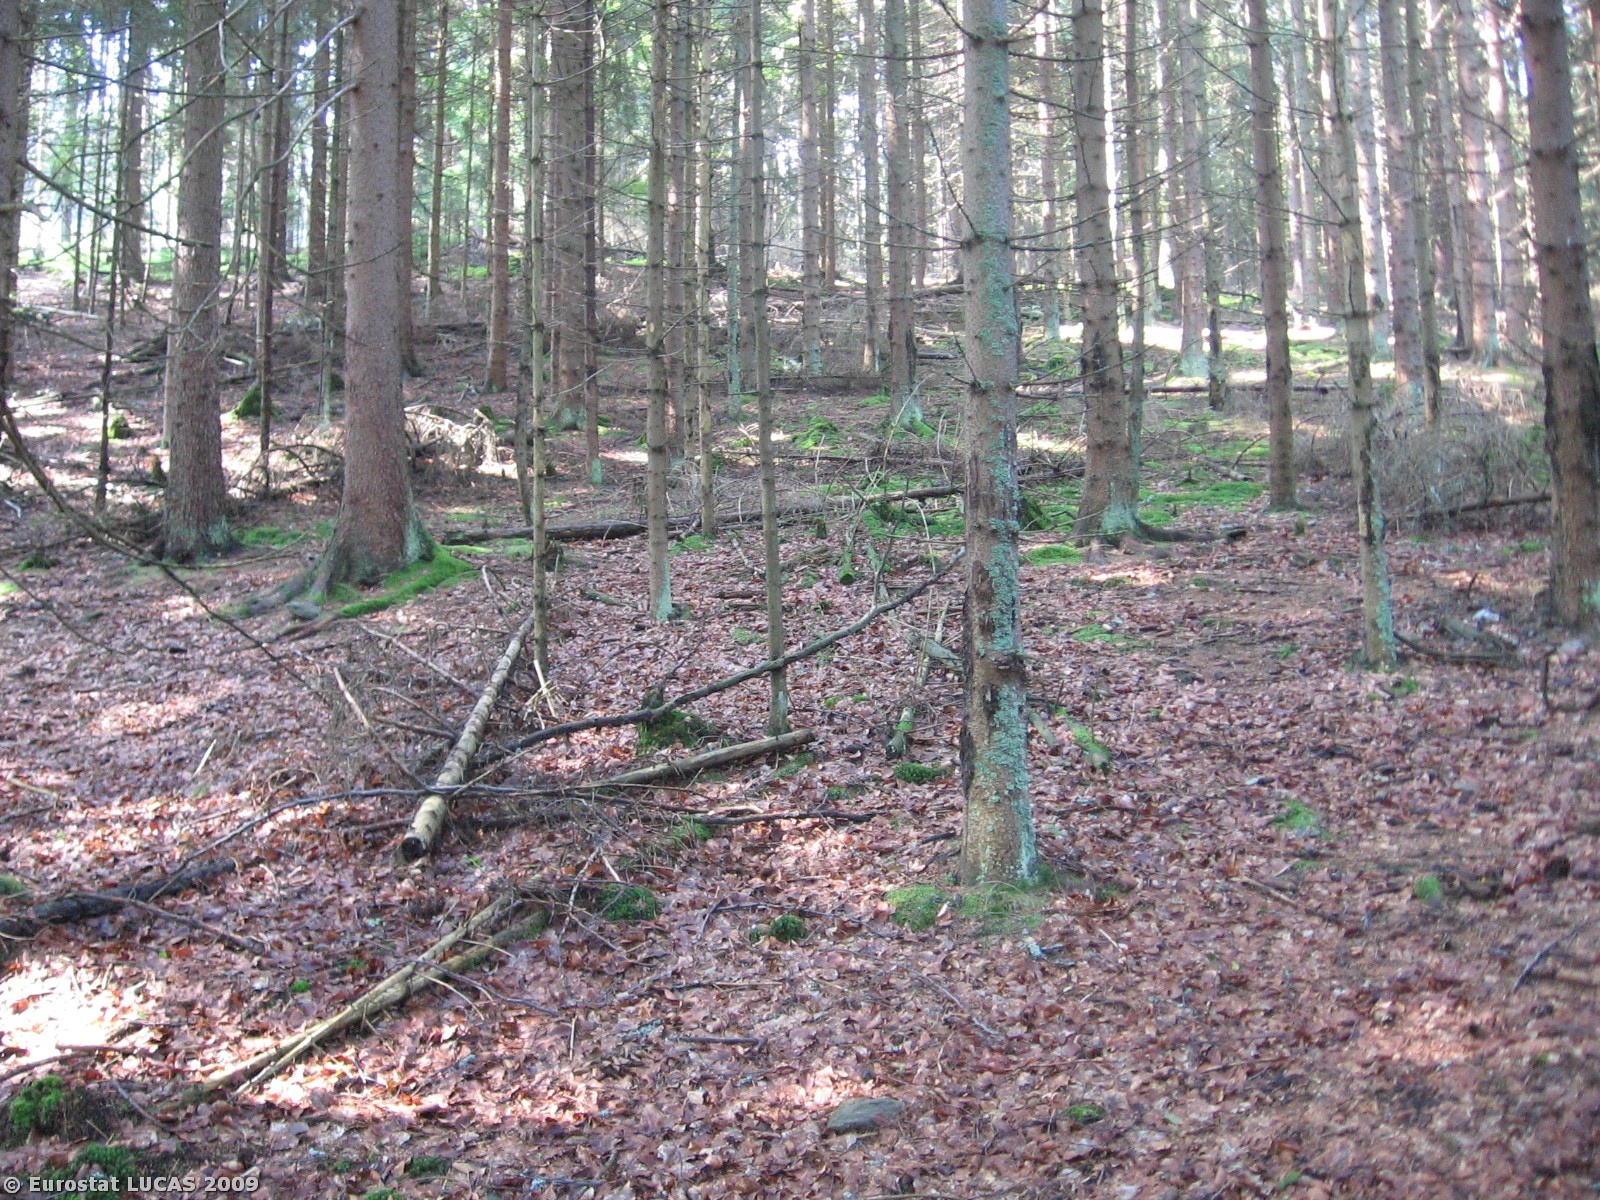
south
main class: Woodland
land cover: Coniferous woodland
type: hemiboreal forest and nemoral coniferous forest and mixed broadleaved-coniferous forest
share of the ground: > 75 %
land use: Forestry
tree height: > 5 m
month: July
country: CZ
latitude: 49.2222
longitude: 13.1715
